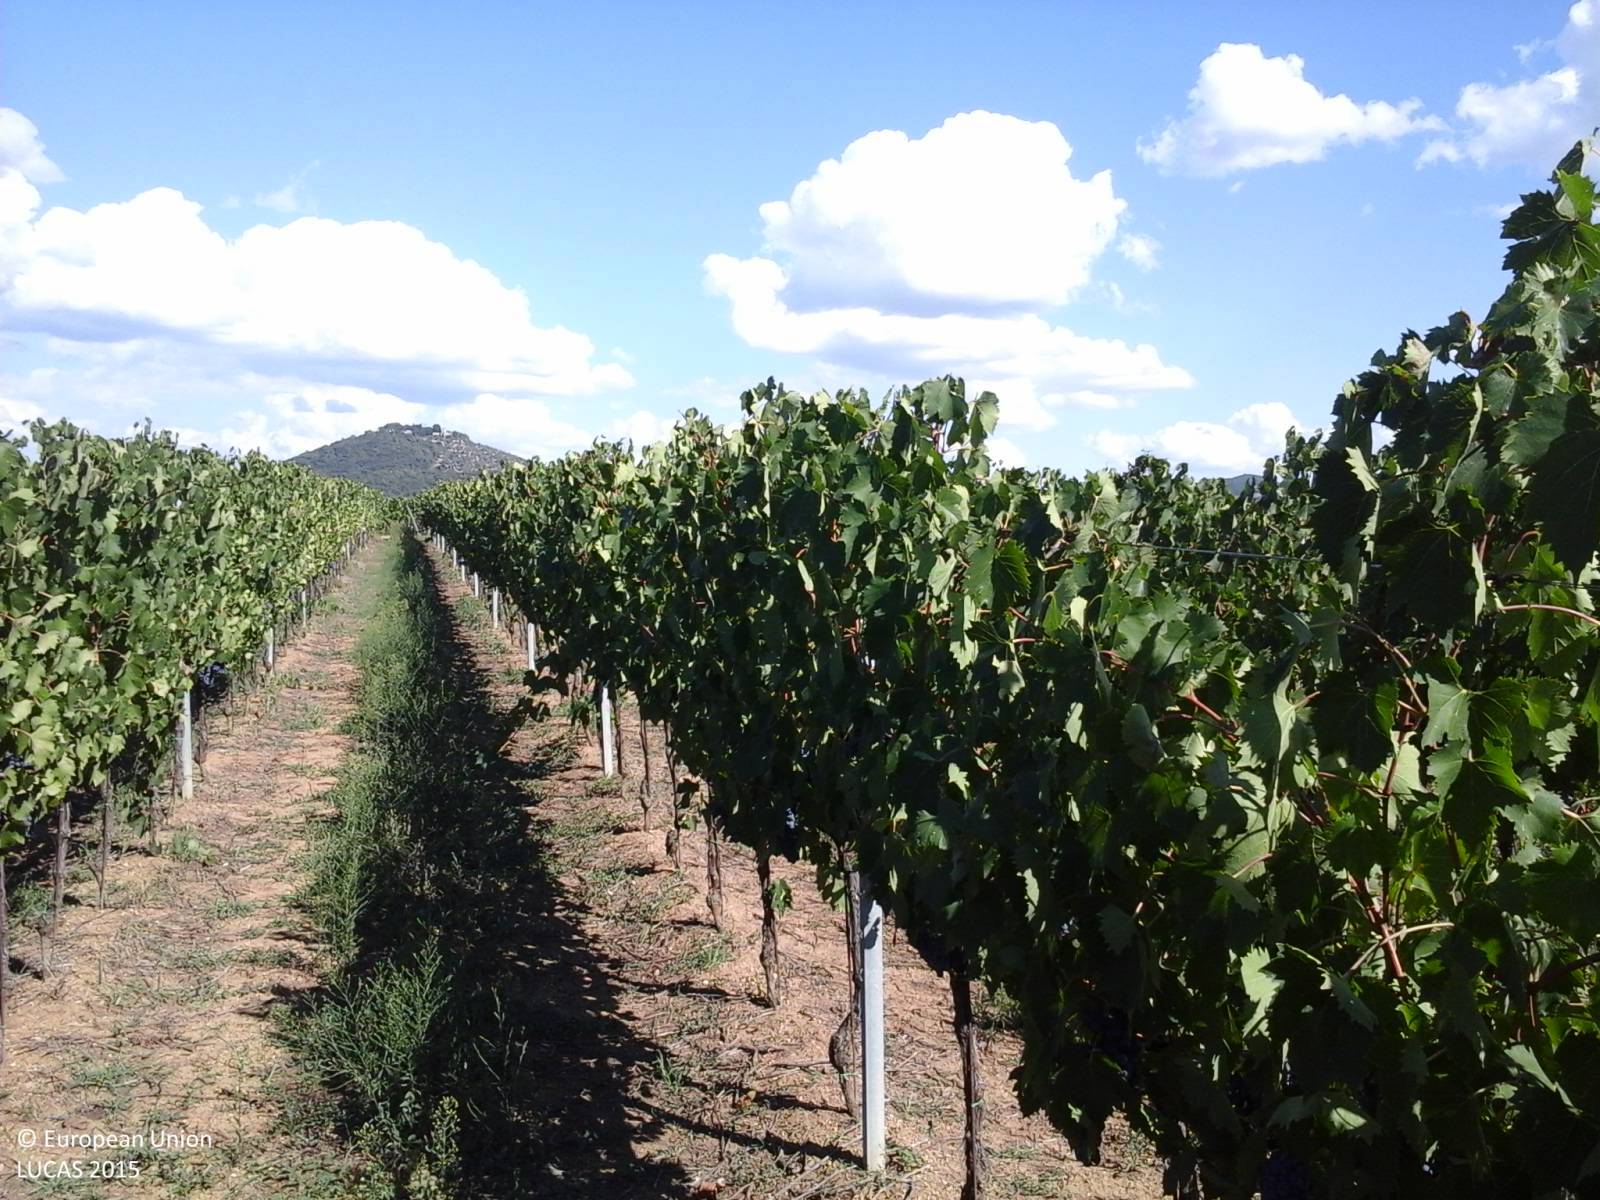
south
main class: Cropland
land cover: Vineyards
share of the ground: 25 - 50 %
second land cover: Spontaneously vegetated surfaces
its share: > 75 %
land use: Agriculture (excluding fallow land and kitchen gardens)
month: September
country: IT
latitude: 43.0659
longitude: 12.0936
